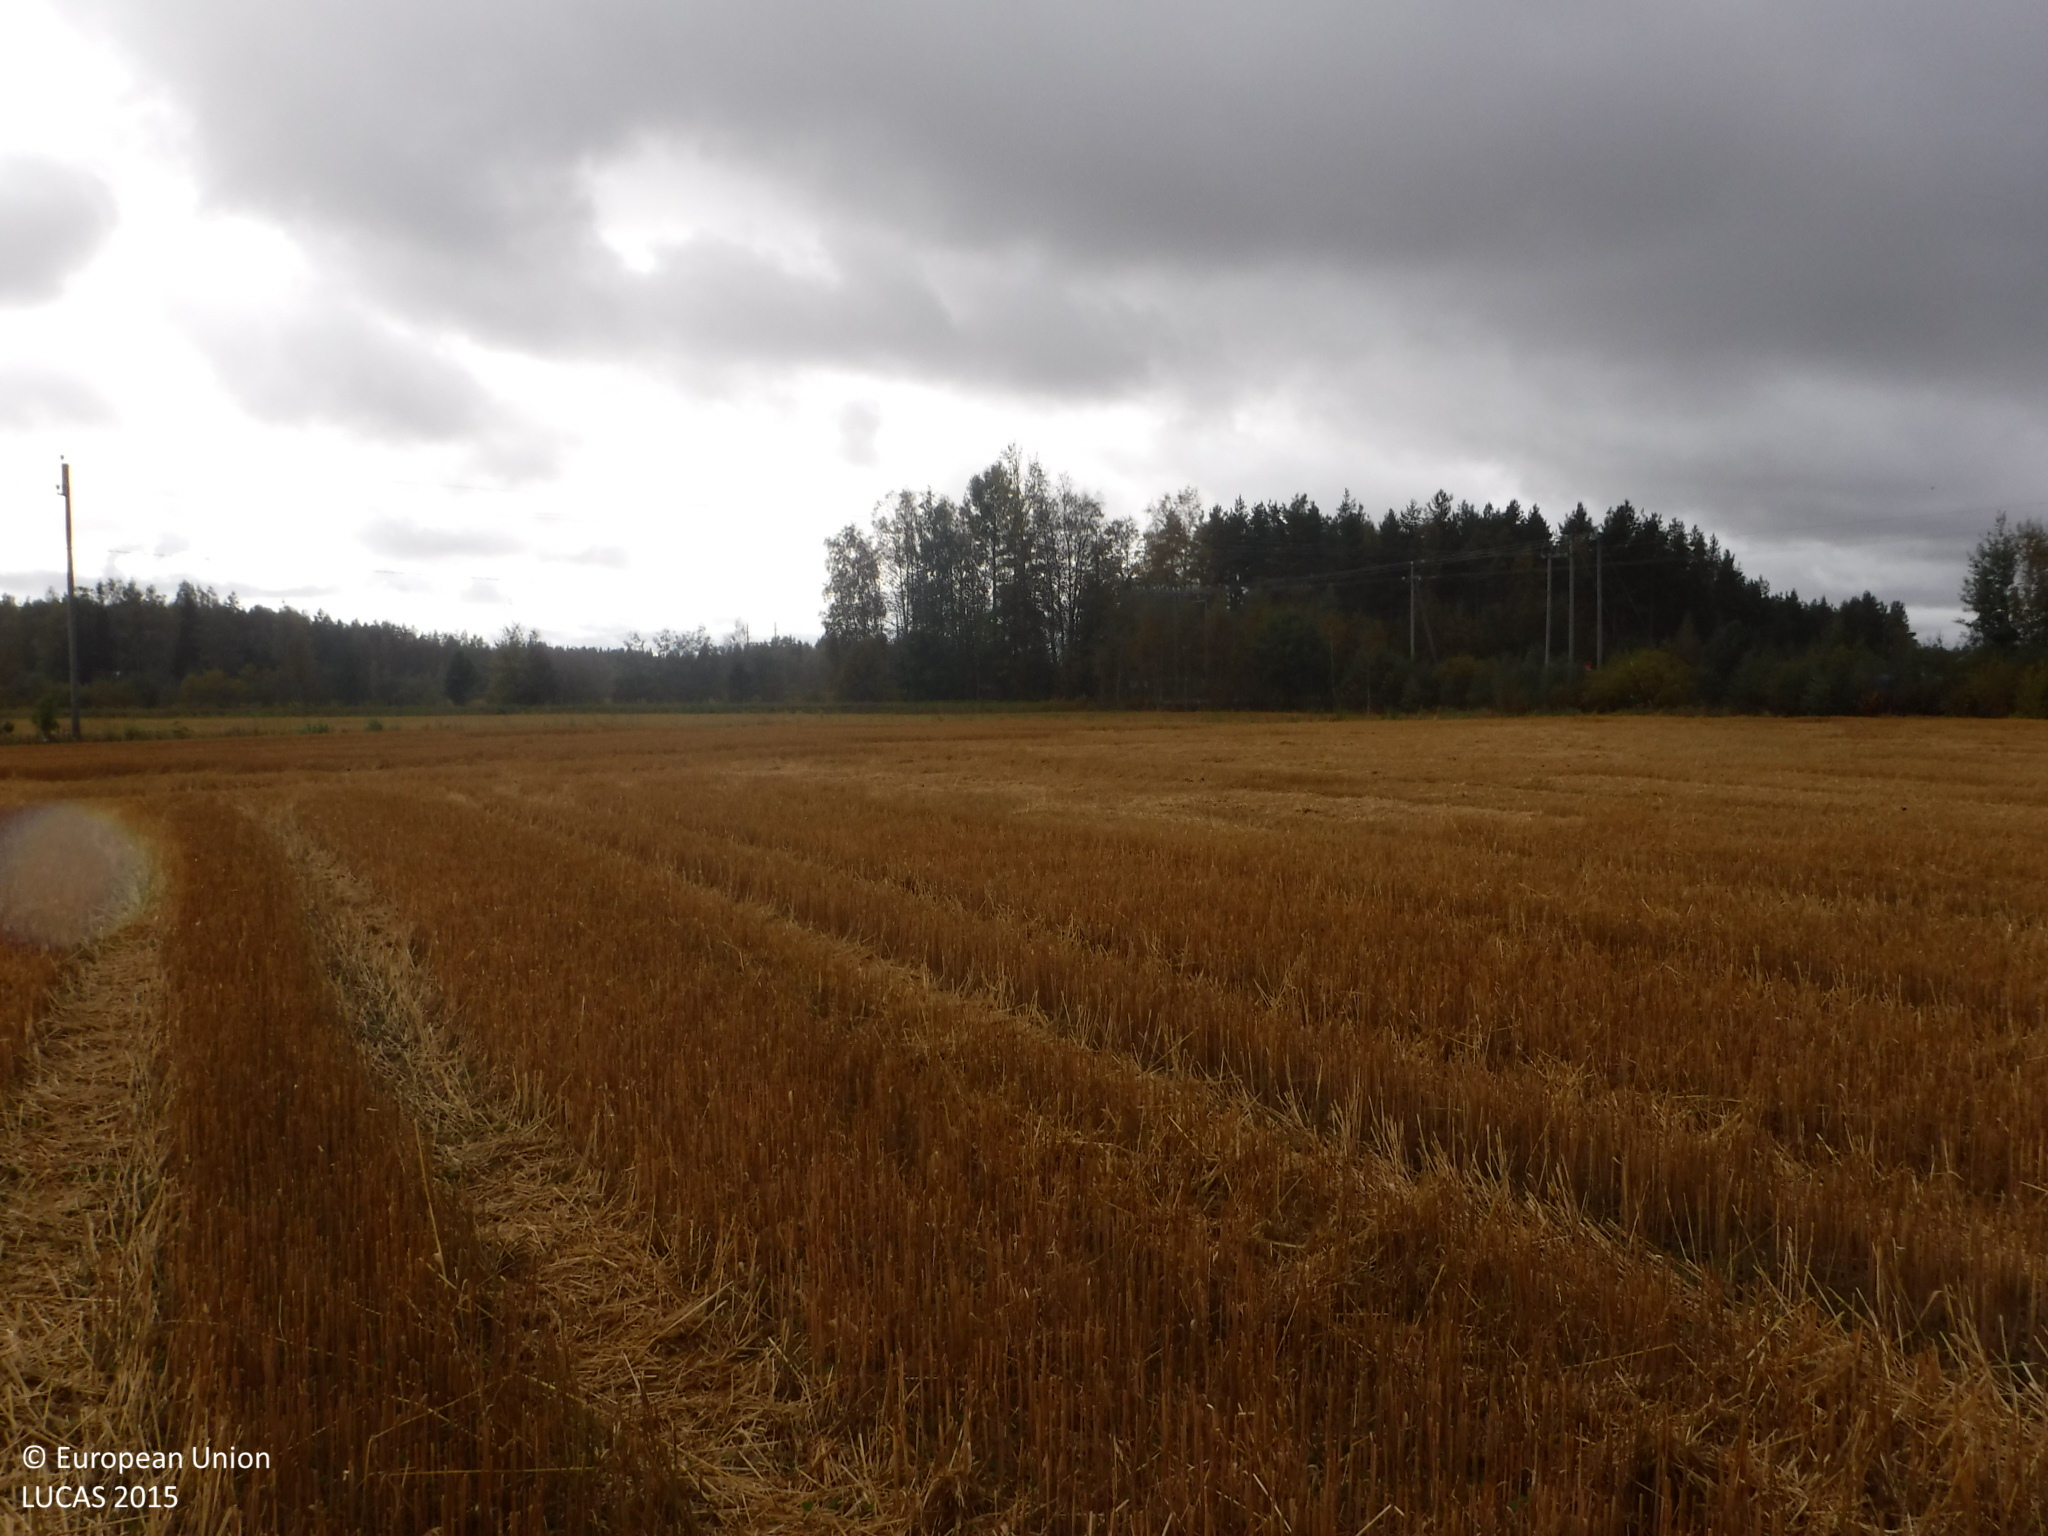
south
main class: Cropland
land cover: Oats
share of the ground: > 75 %
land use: Agriculture (excluding fallow land and kitchen gardens)
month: September
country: FI
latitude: 61.9852
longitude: 22.2127
